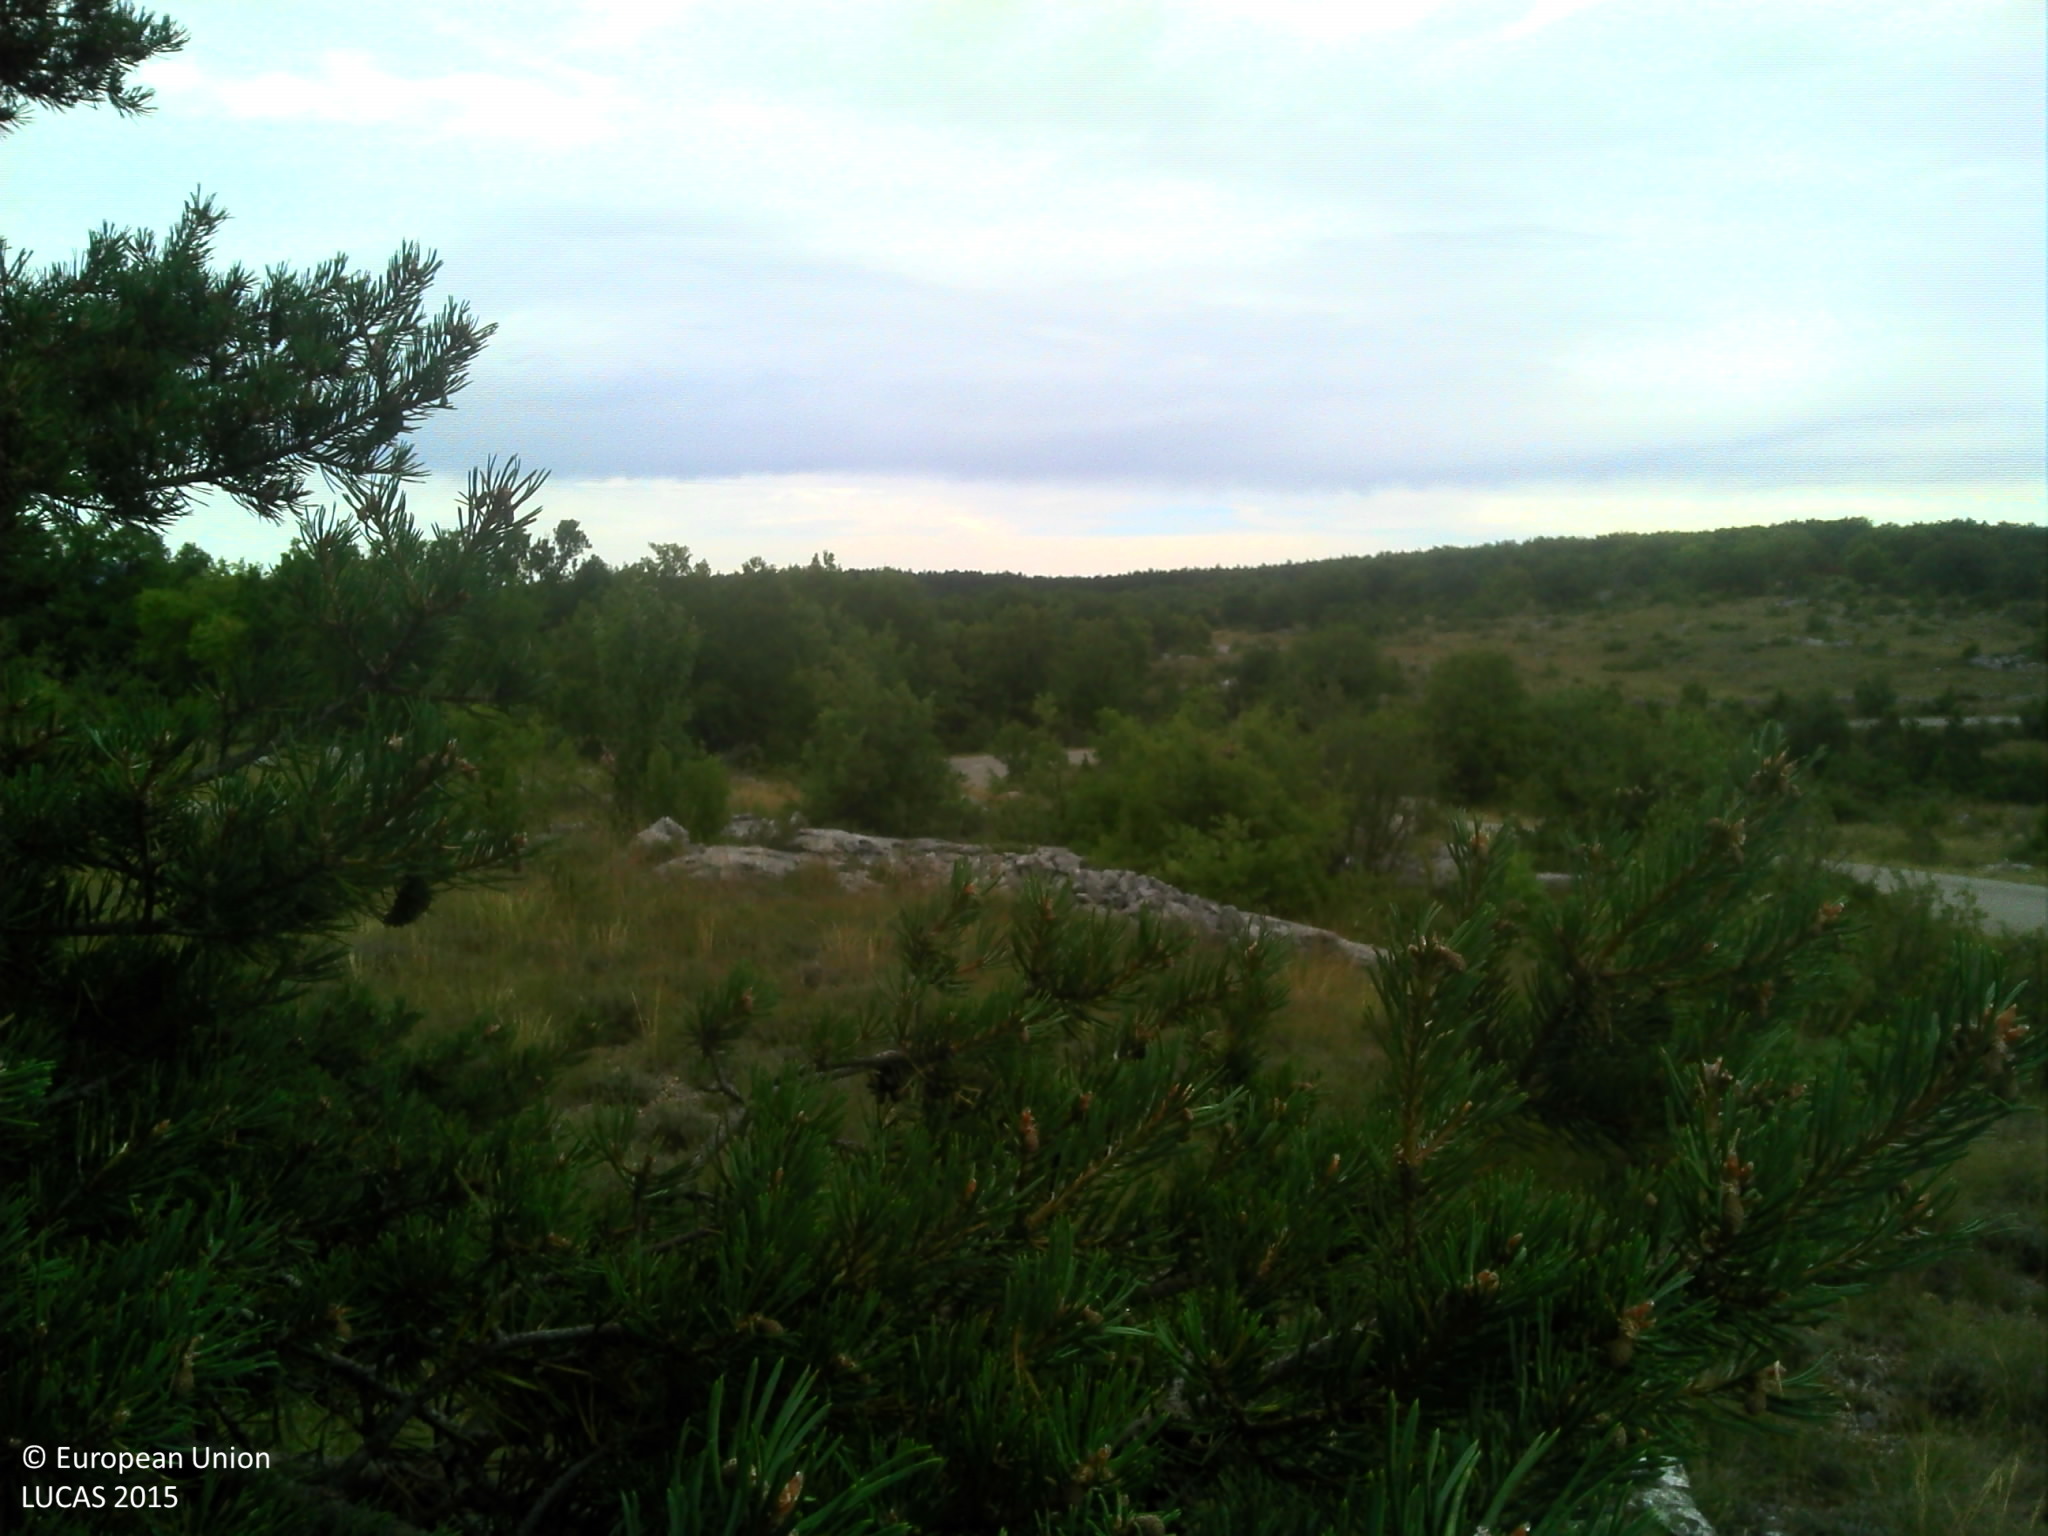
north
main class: Grassland
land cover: Grassland with sparse tree/shrub cover
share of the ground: > 75 %
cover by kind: herbaceous plants 75 %, consolidated bare surface 15 %, coniferous forest trees 5 %, shrubs 5 %
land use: Semi-natural and natural areas not in use
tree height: < 5 m
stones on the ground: 25 - 50 %
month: July
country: FR
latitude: 44.0014
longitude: 5.5311
